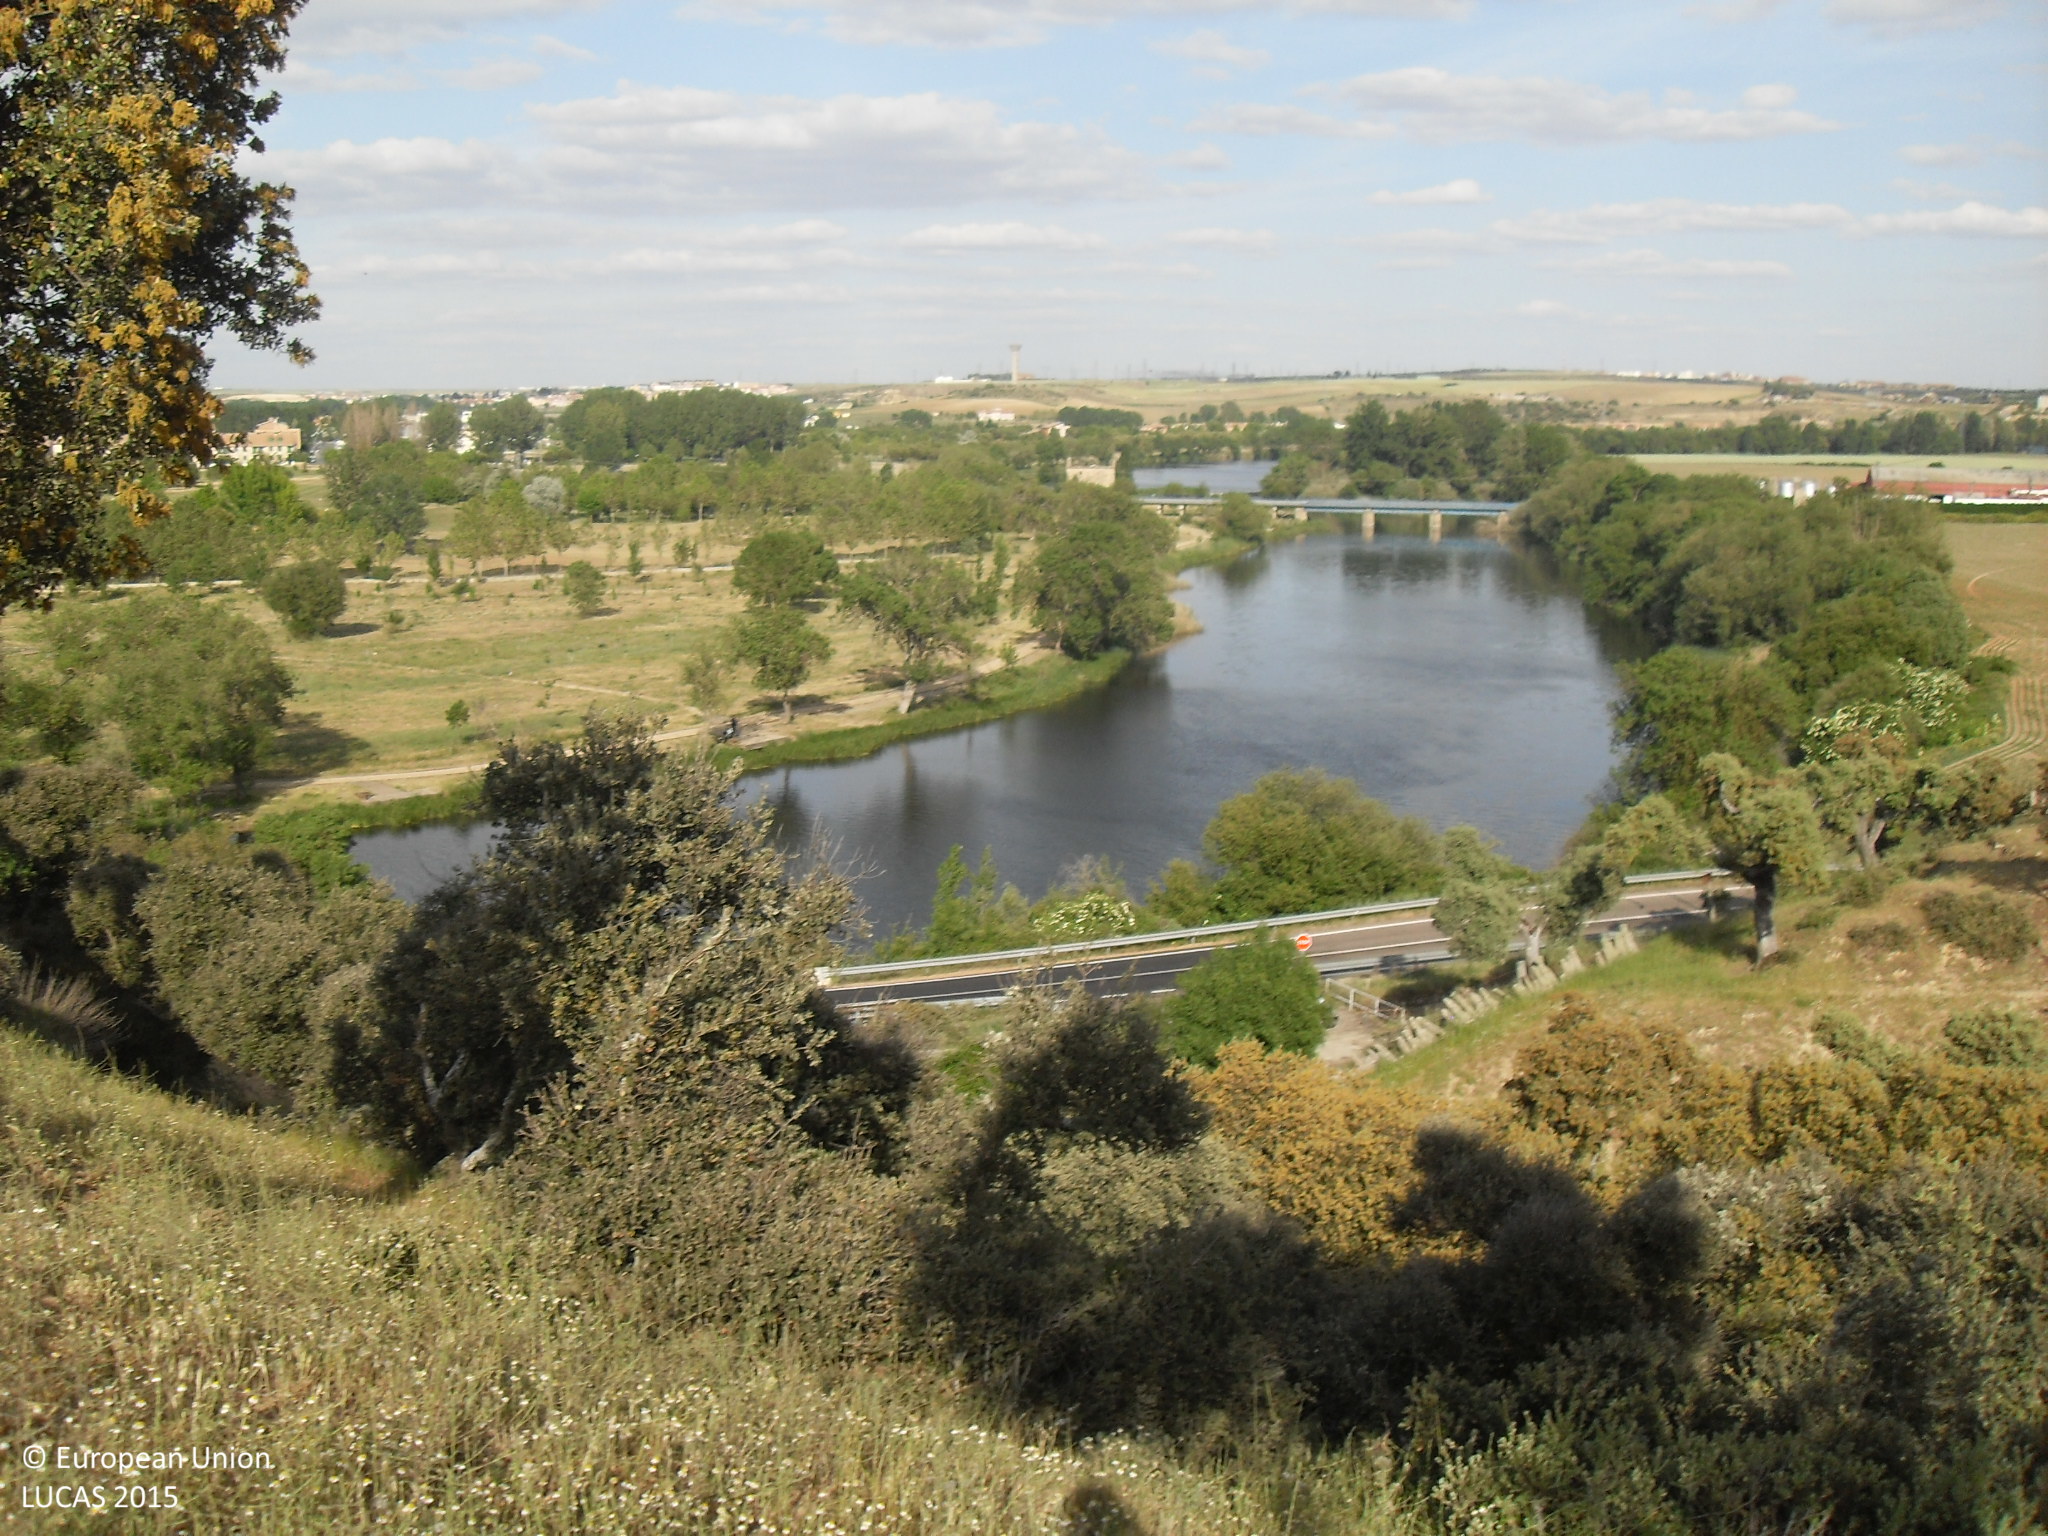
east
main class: Woodland
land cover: Broadleaved woodland
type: broadleaved evergreen forest
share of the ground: 10 - 25 %
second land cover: Grassland without tree/shrub cover
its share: > 75 %
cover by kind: herbaceous plants 80 %, broadleaved forest trees 20 %
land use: Forestry
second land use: Agriculture (excluding fallow land and kitchen gardens)
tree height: < 5 m
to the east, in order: Broadleaved woodland; Grassland without tree/shrub cover; Rocks and stones; Ditches and canals; Grass margins; Paved roads, cycling and walking lanes; Grass margins; Abandoned hedges; Inland fresh running water; Abandoned hedges; Grass margins; Tracks; Grassland without tree/shrub cover
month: May
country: ES
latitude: 40.9927
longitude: -5.7344
